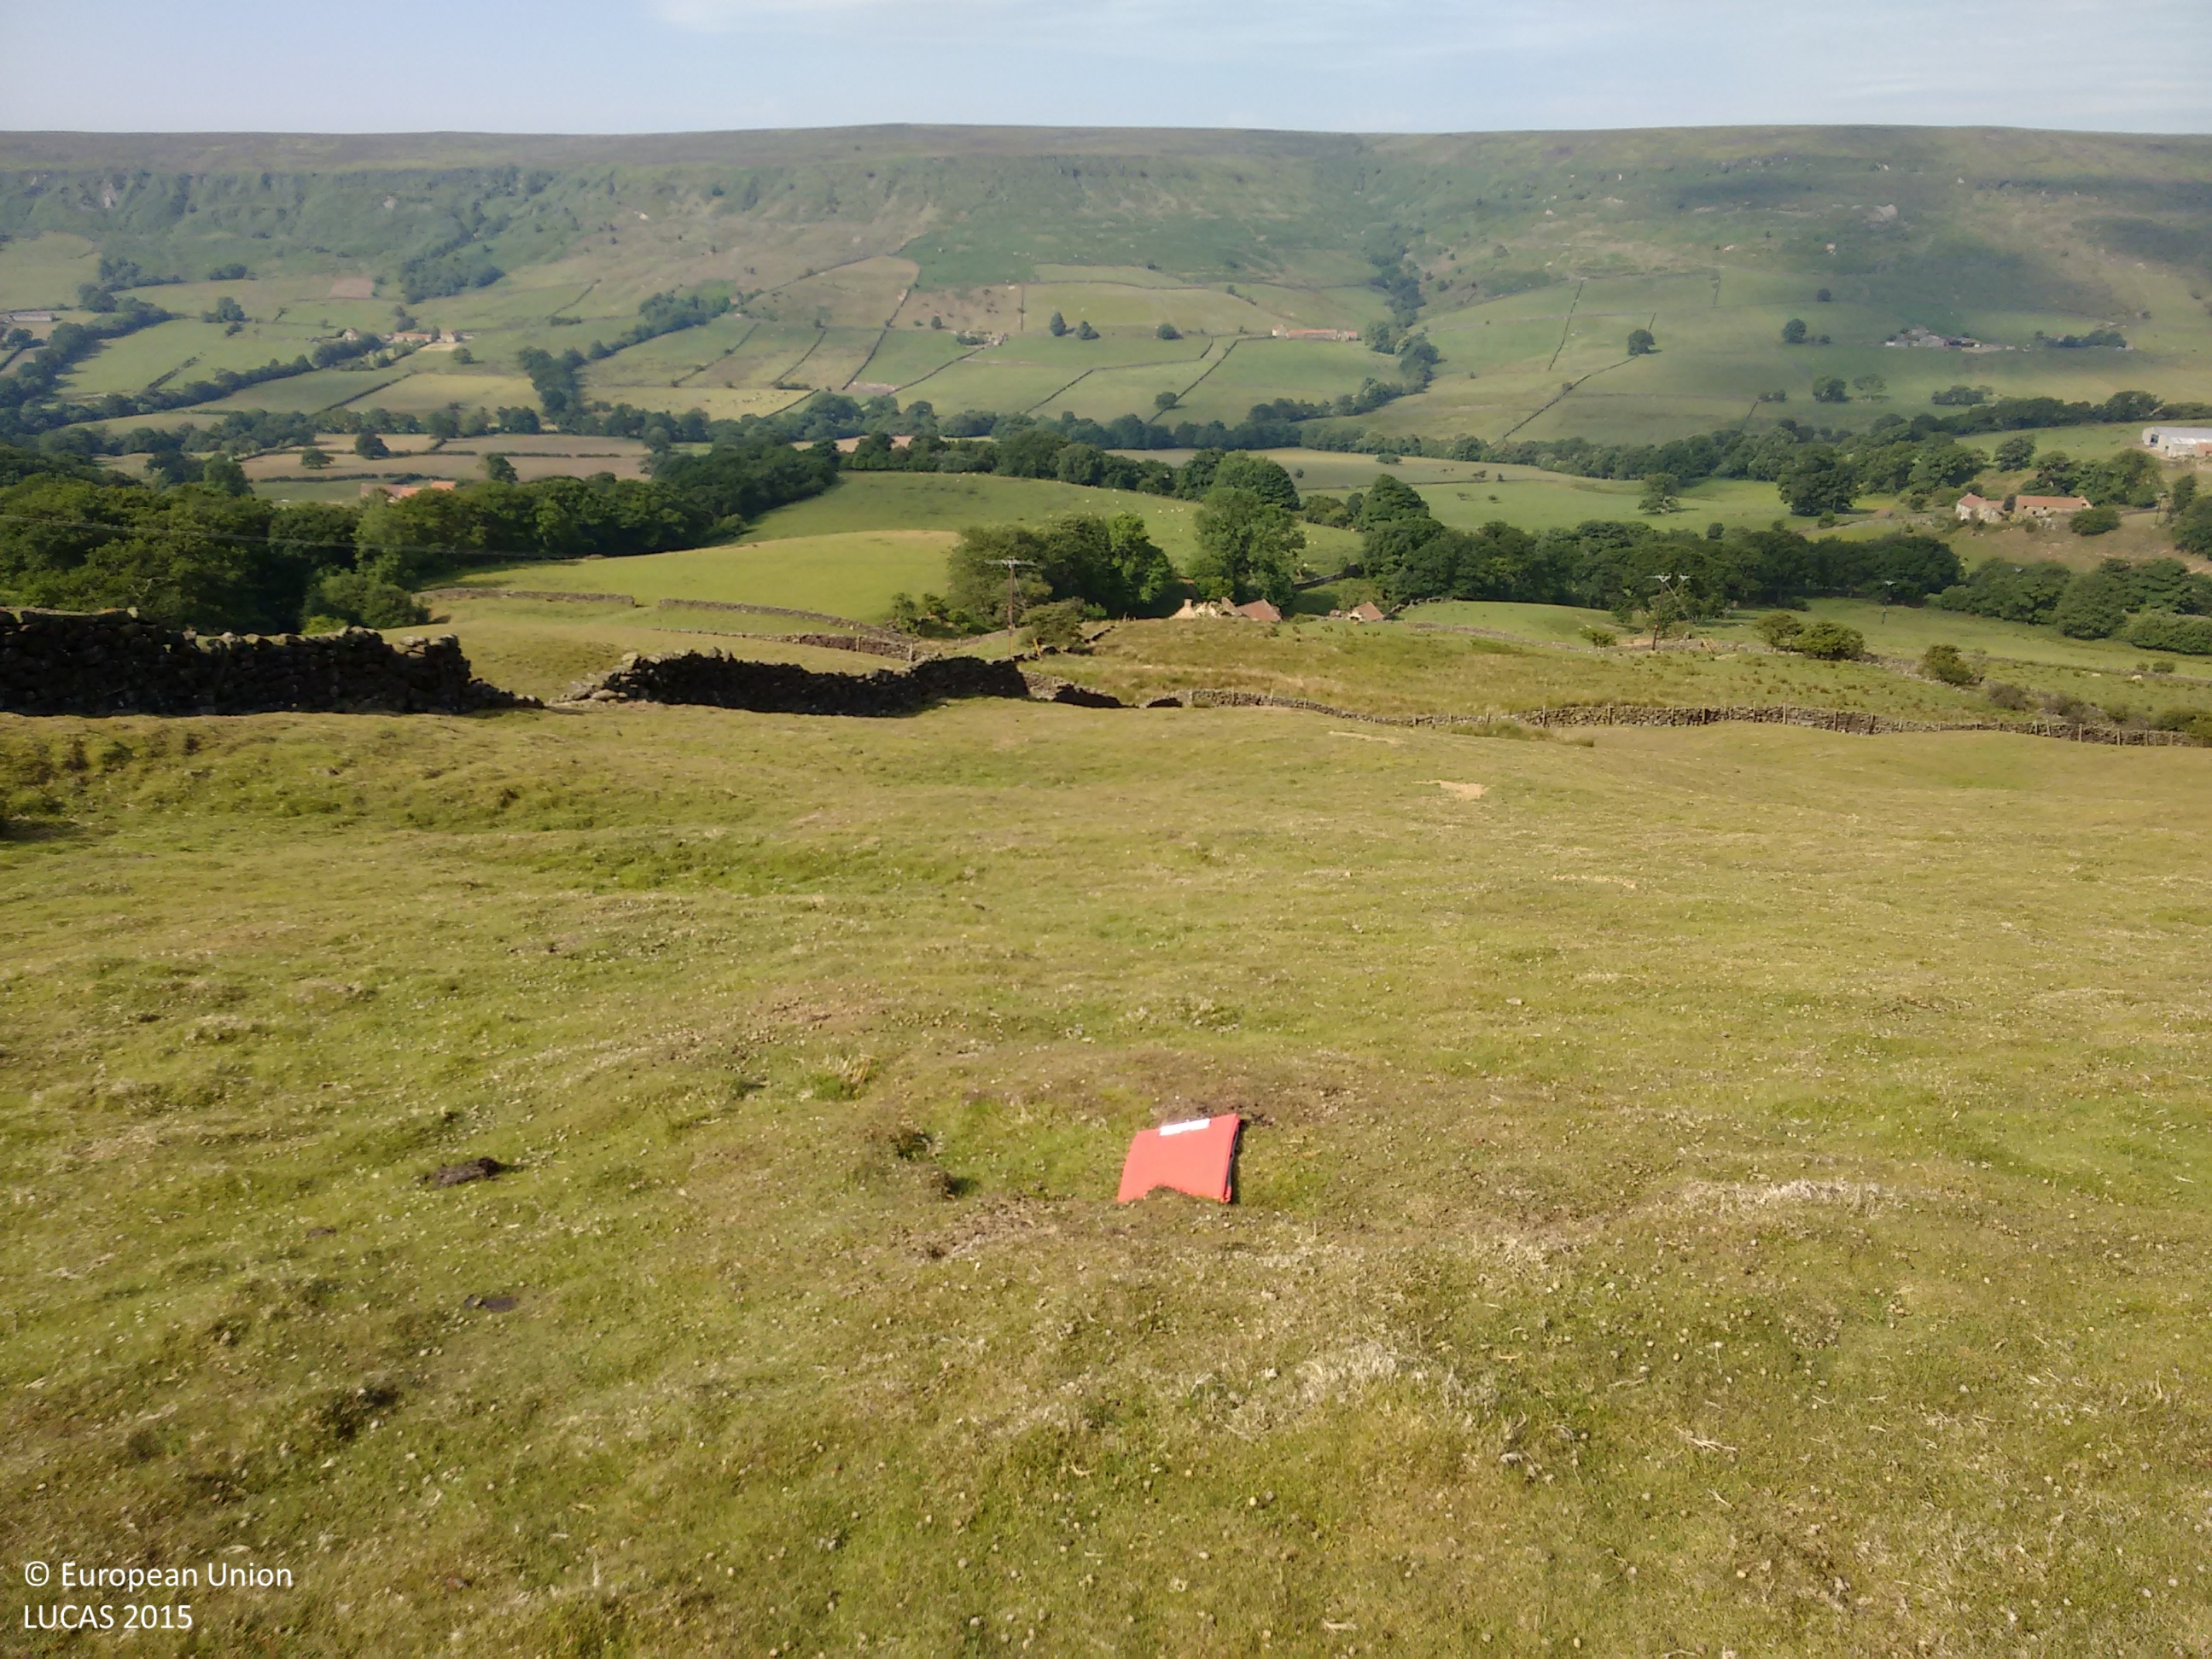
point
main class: Grassland
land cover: Grassland without tree/shrub cover
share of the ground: > 75 %
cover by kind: herbaceous plants 100 %
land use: Agriculture (excluding fallow land and kitchen gardens)
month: July
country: GB
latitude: 54.3885
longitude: -0.9909
